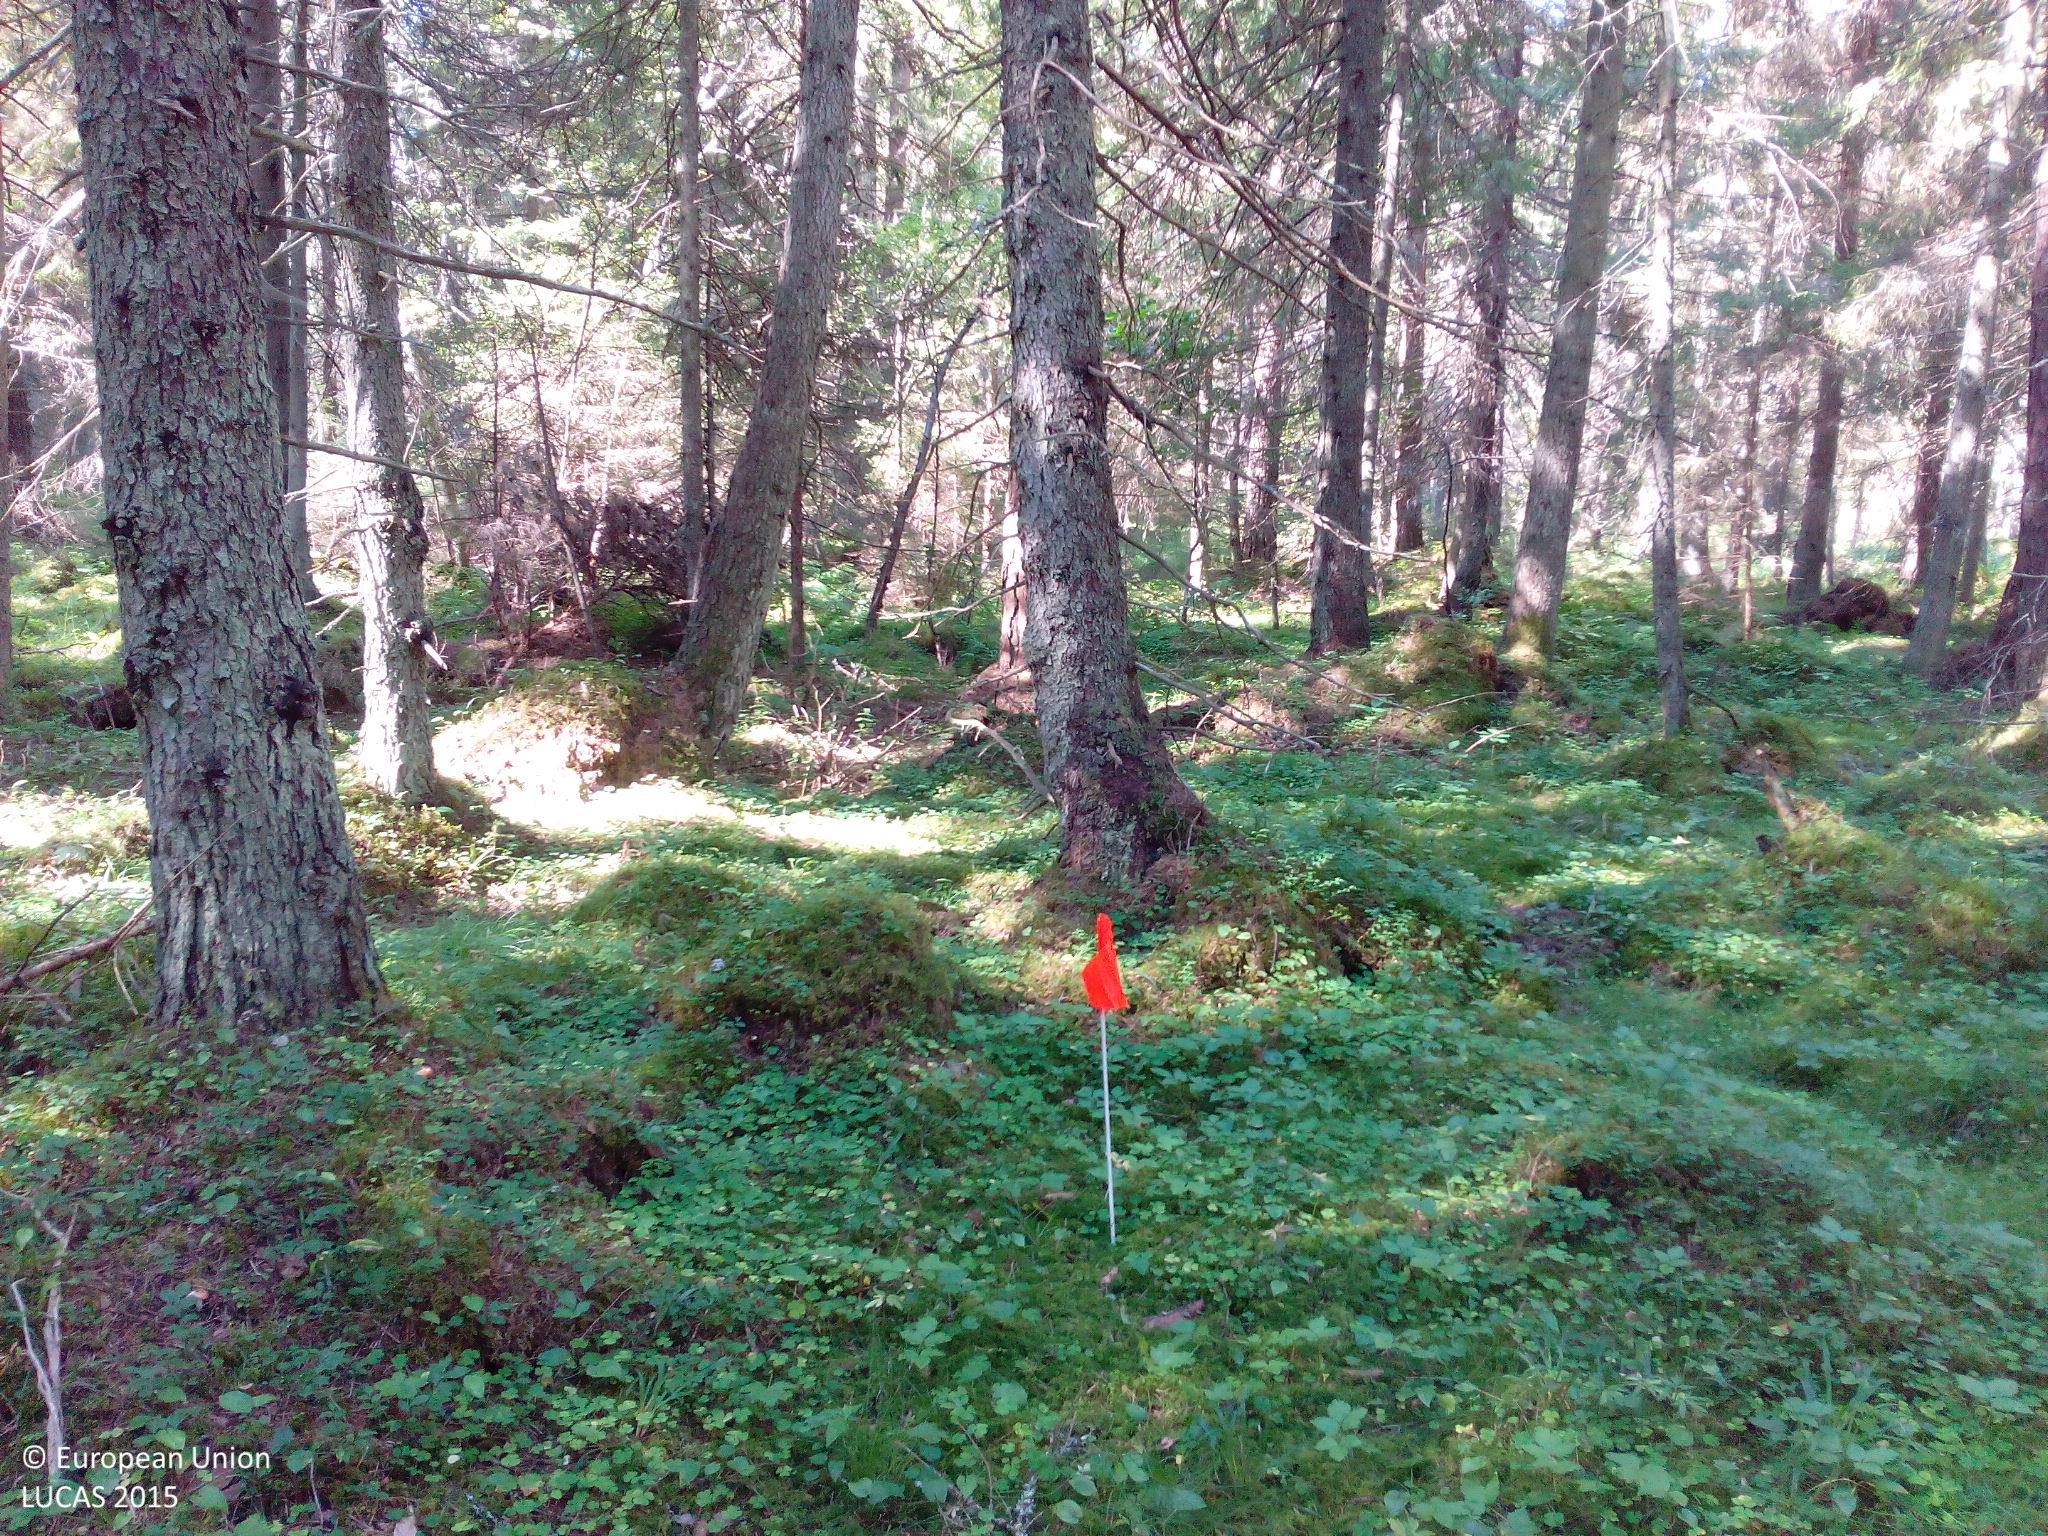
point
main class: Woodland
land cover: Spruce dominated coniferous woodland
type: hemiboreal forest and nemoral coniferous forest and mixed broadleaved-coniferous forest
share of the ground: > 75 %
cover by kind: coniferous forest trees 90 %, herbaceous plants 5 %, lichens and mosses 5 %
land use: Forestry
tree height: > 5 m
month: August
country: FI
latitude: 60.1410
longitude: 19.8921
